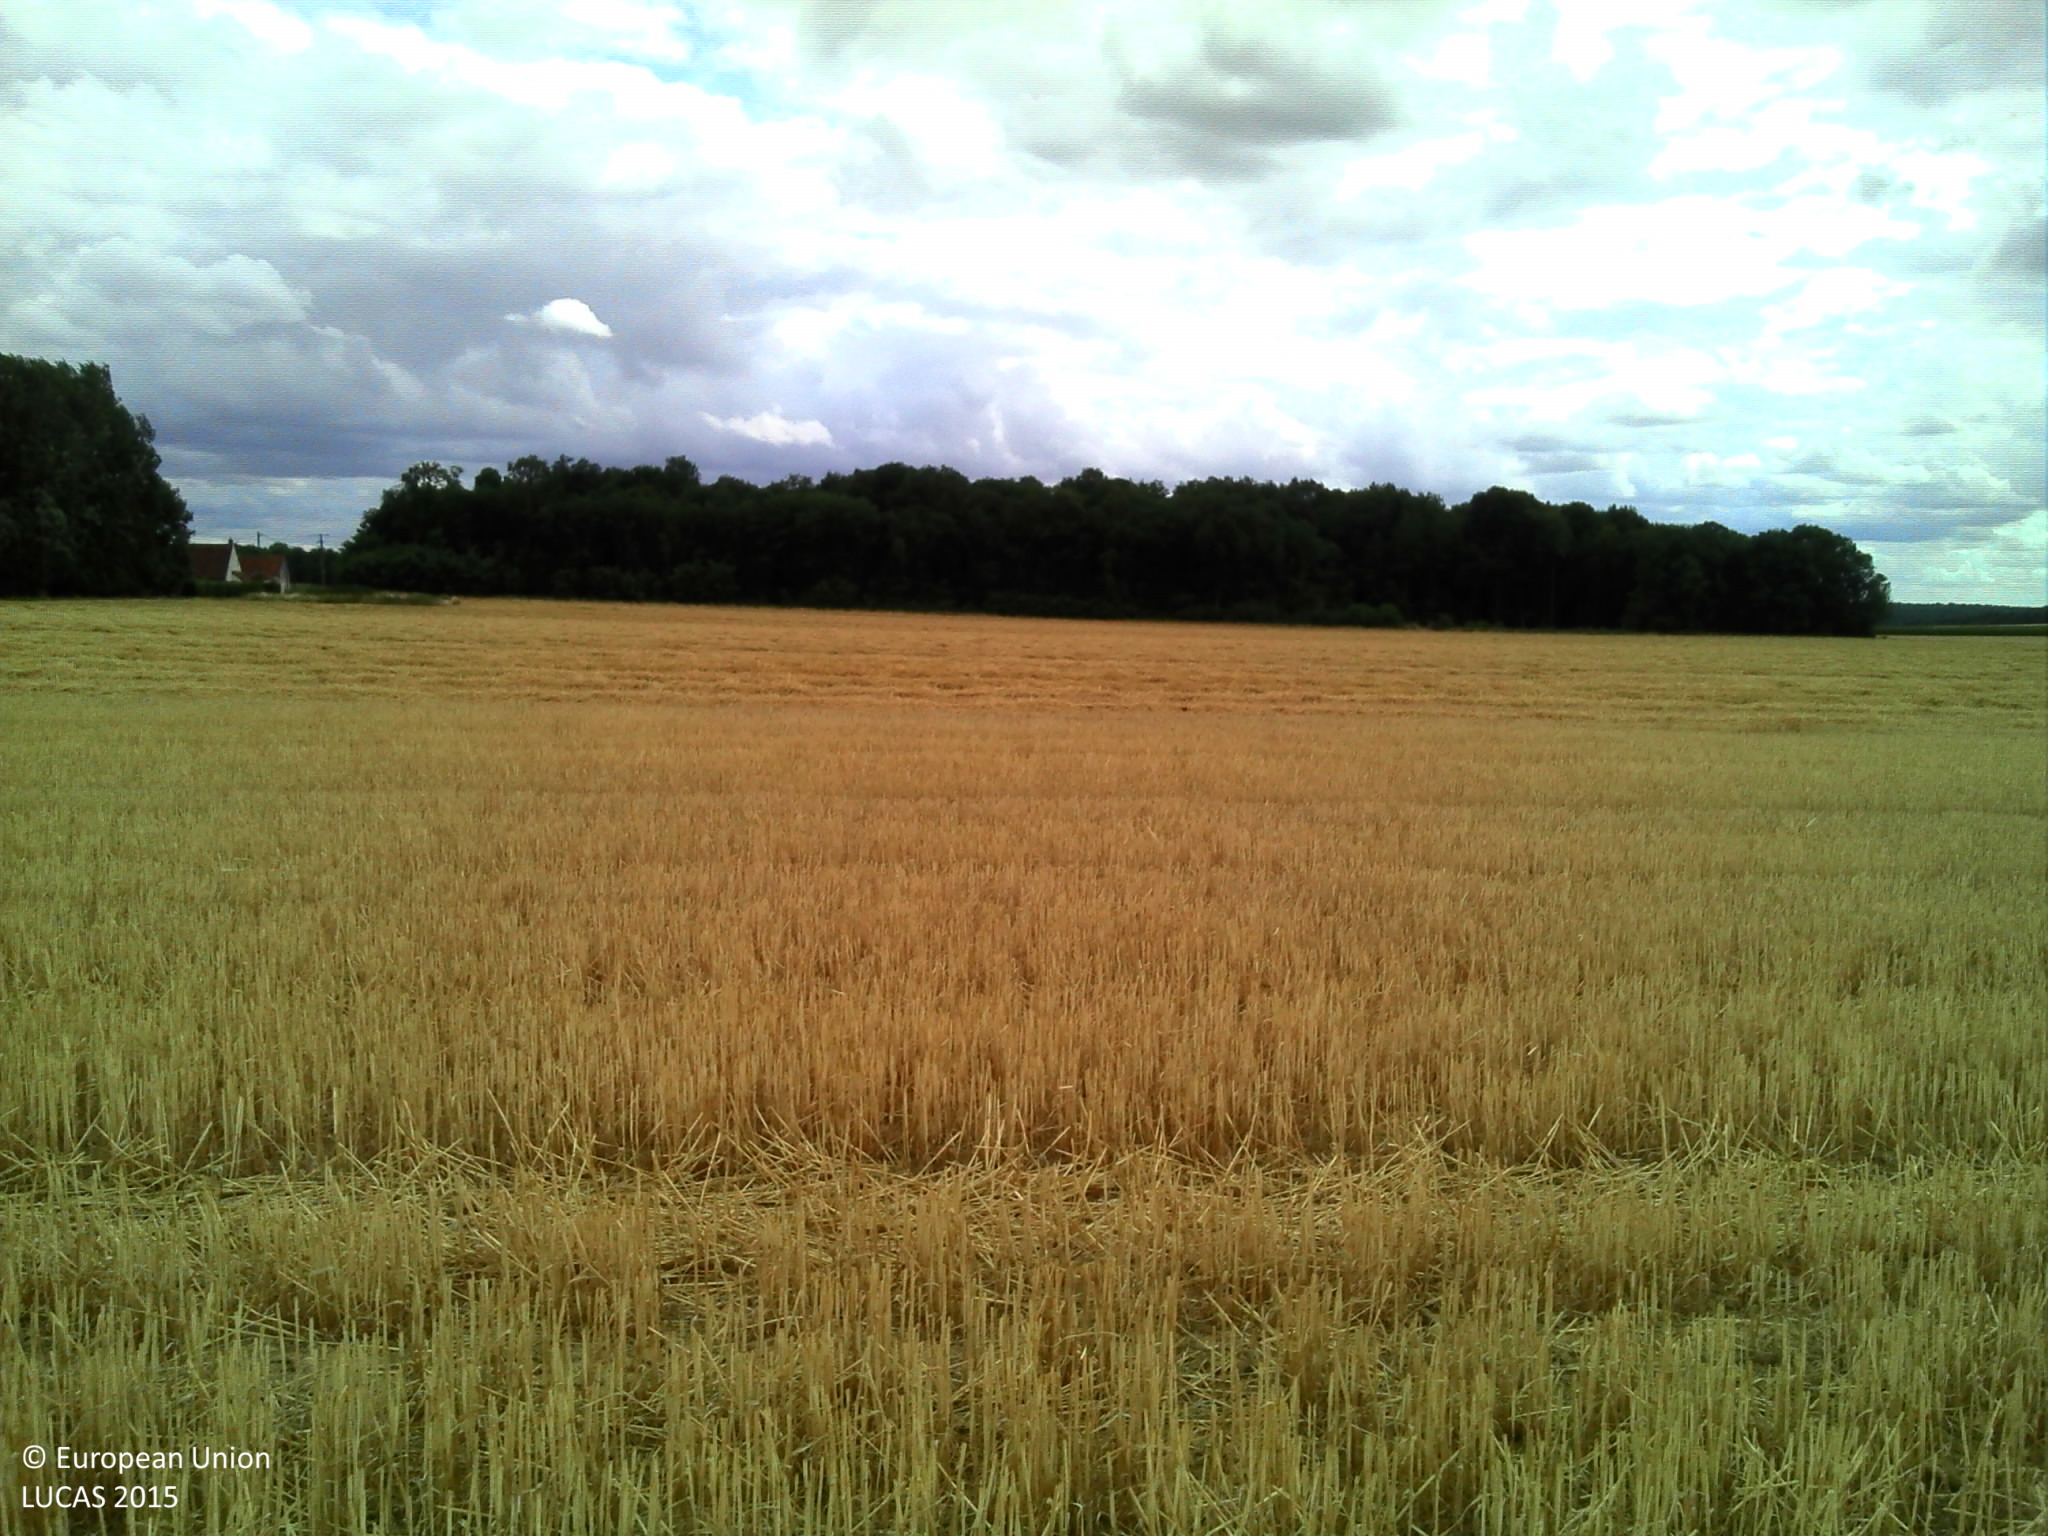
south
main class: Cropland
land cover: Common wheat
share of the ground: > 75 %
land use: Agriculture (excluding fallow land and kitchen gardens)
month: July
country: FR
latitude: 48.7671
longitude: 3.4219
